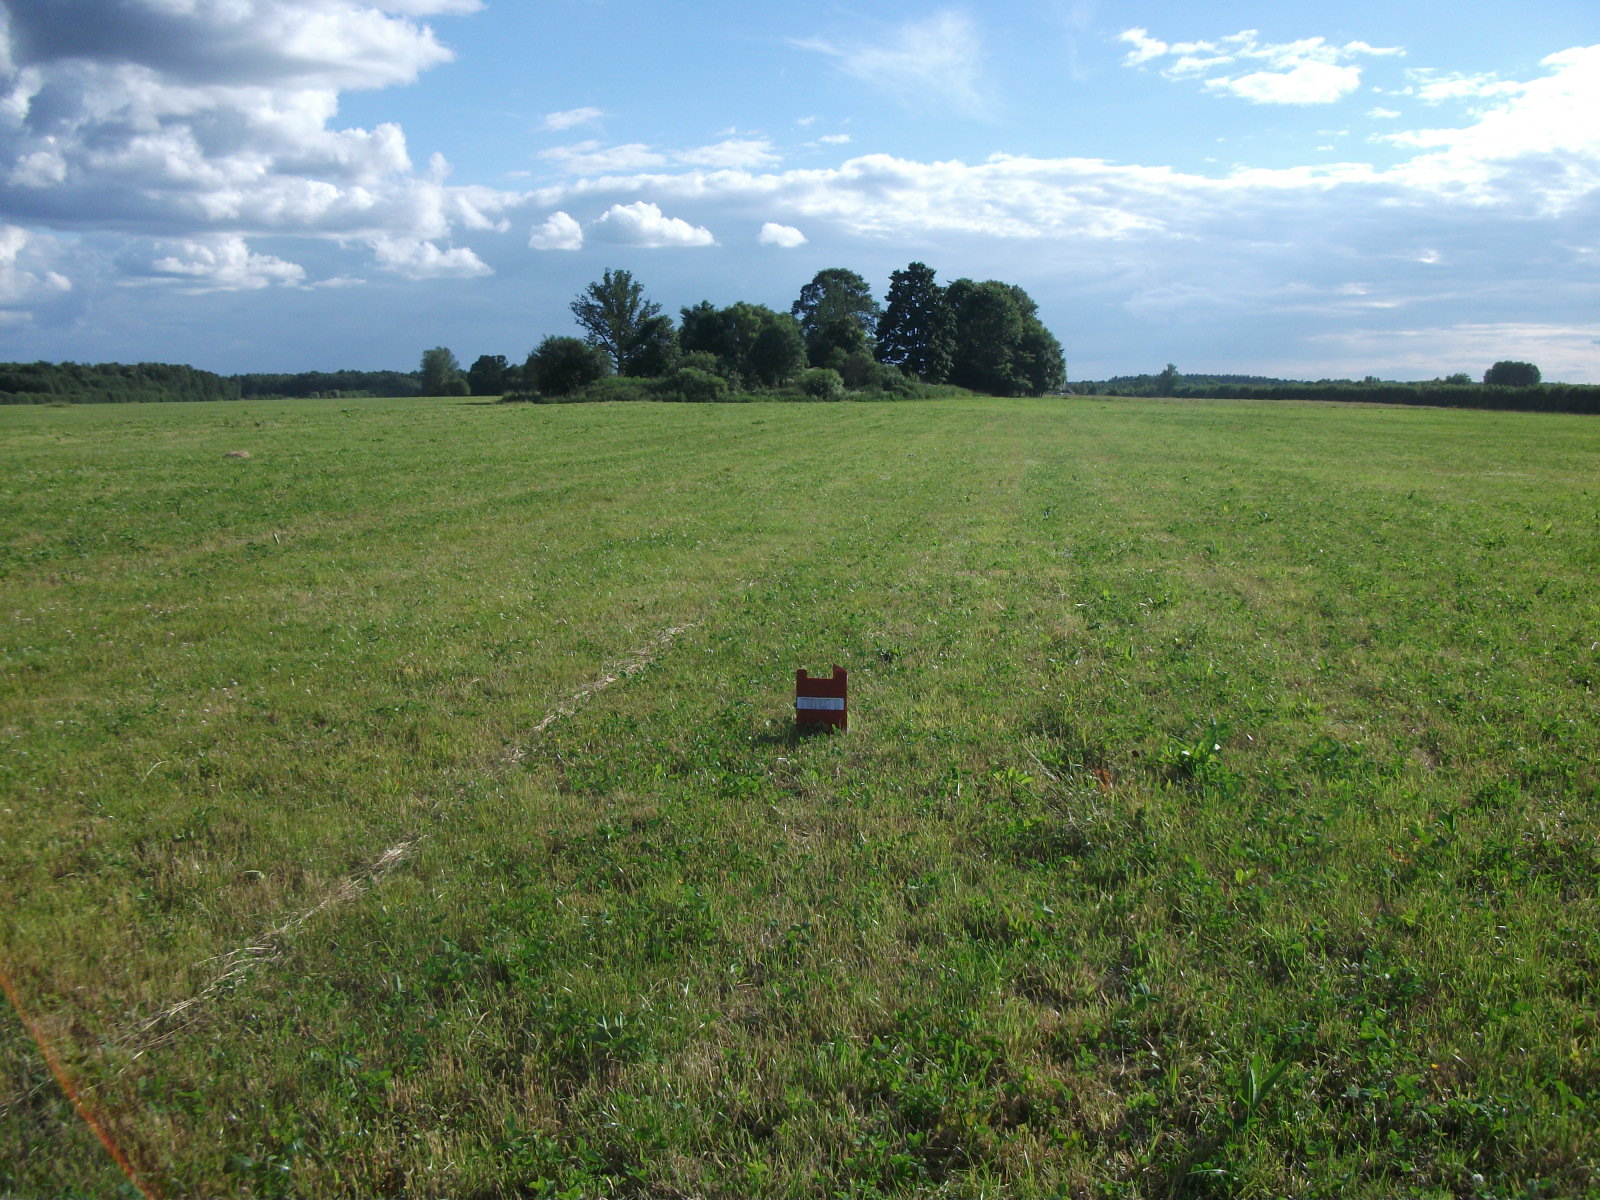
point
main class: Grassland
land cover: Grassland without tree/shrub cover
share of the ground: > 75 %
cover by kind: herbaceous plants 100 %
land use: Agriculture (excluding fallow land and kitchen gardens)
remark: Harvested field
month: June
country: LV
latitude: 56.9926
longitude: 26.5911
